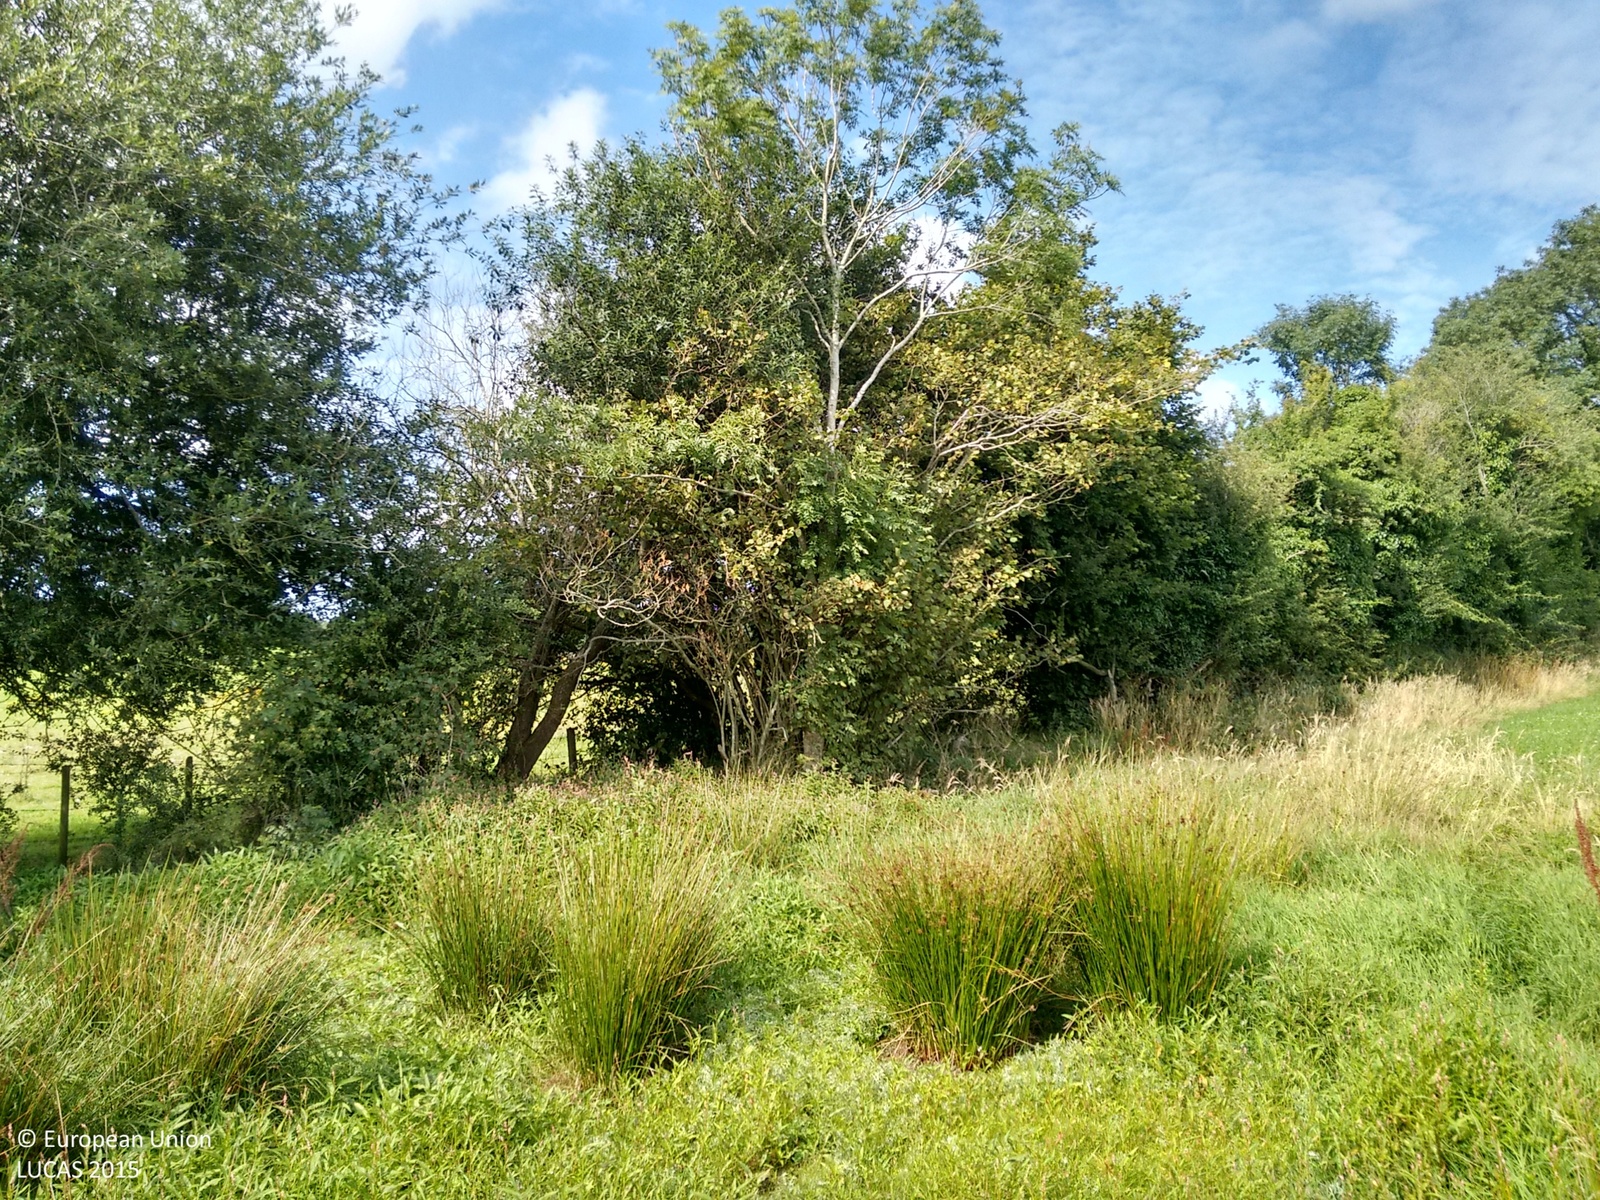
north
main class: Grassland
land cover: Grassland without tree/shrub cover
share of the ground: > 75 %
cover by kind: herbaceous plants 100 %
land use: Agriculture (excluding fallow land and kitchen gardens)
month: August
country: IE
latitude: 52.9643
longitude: -7.4728
